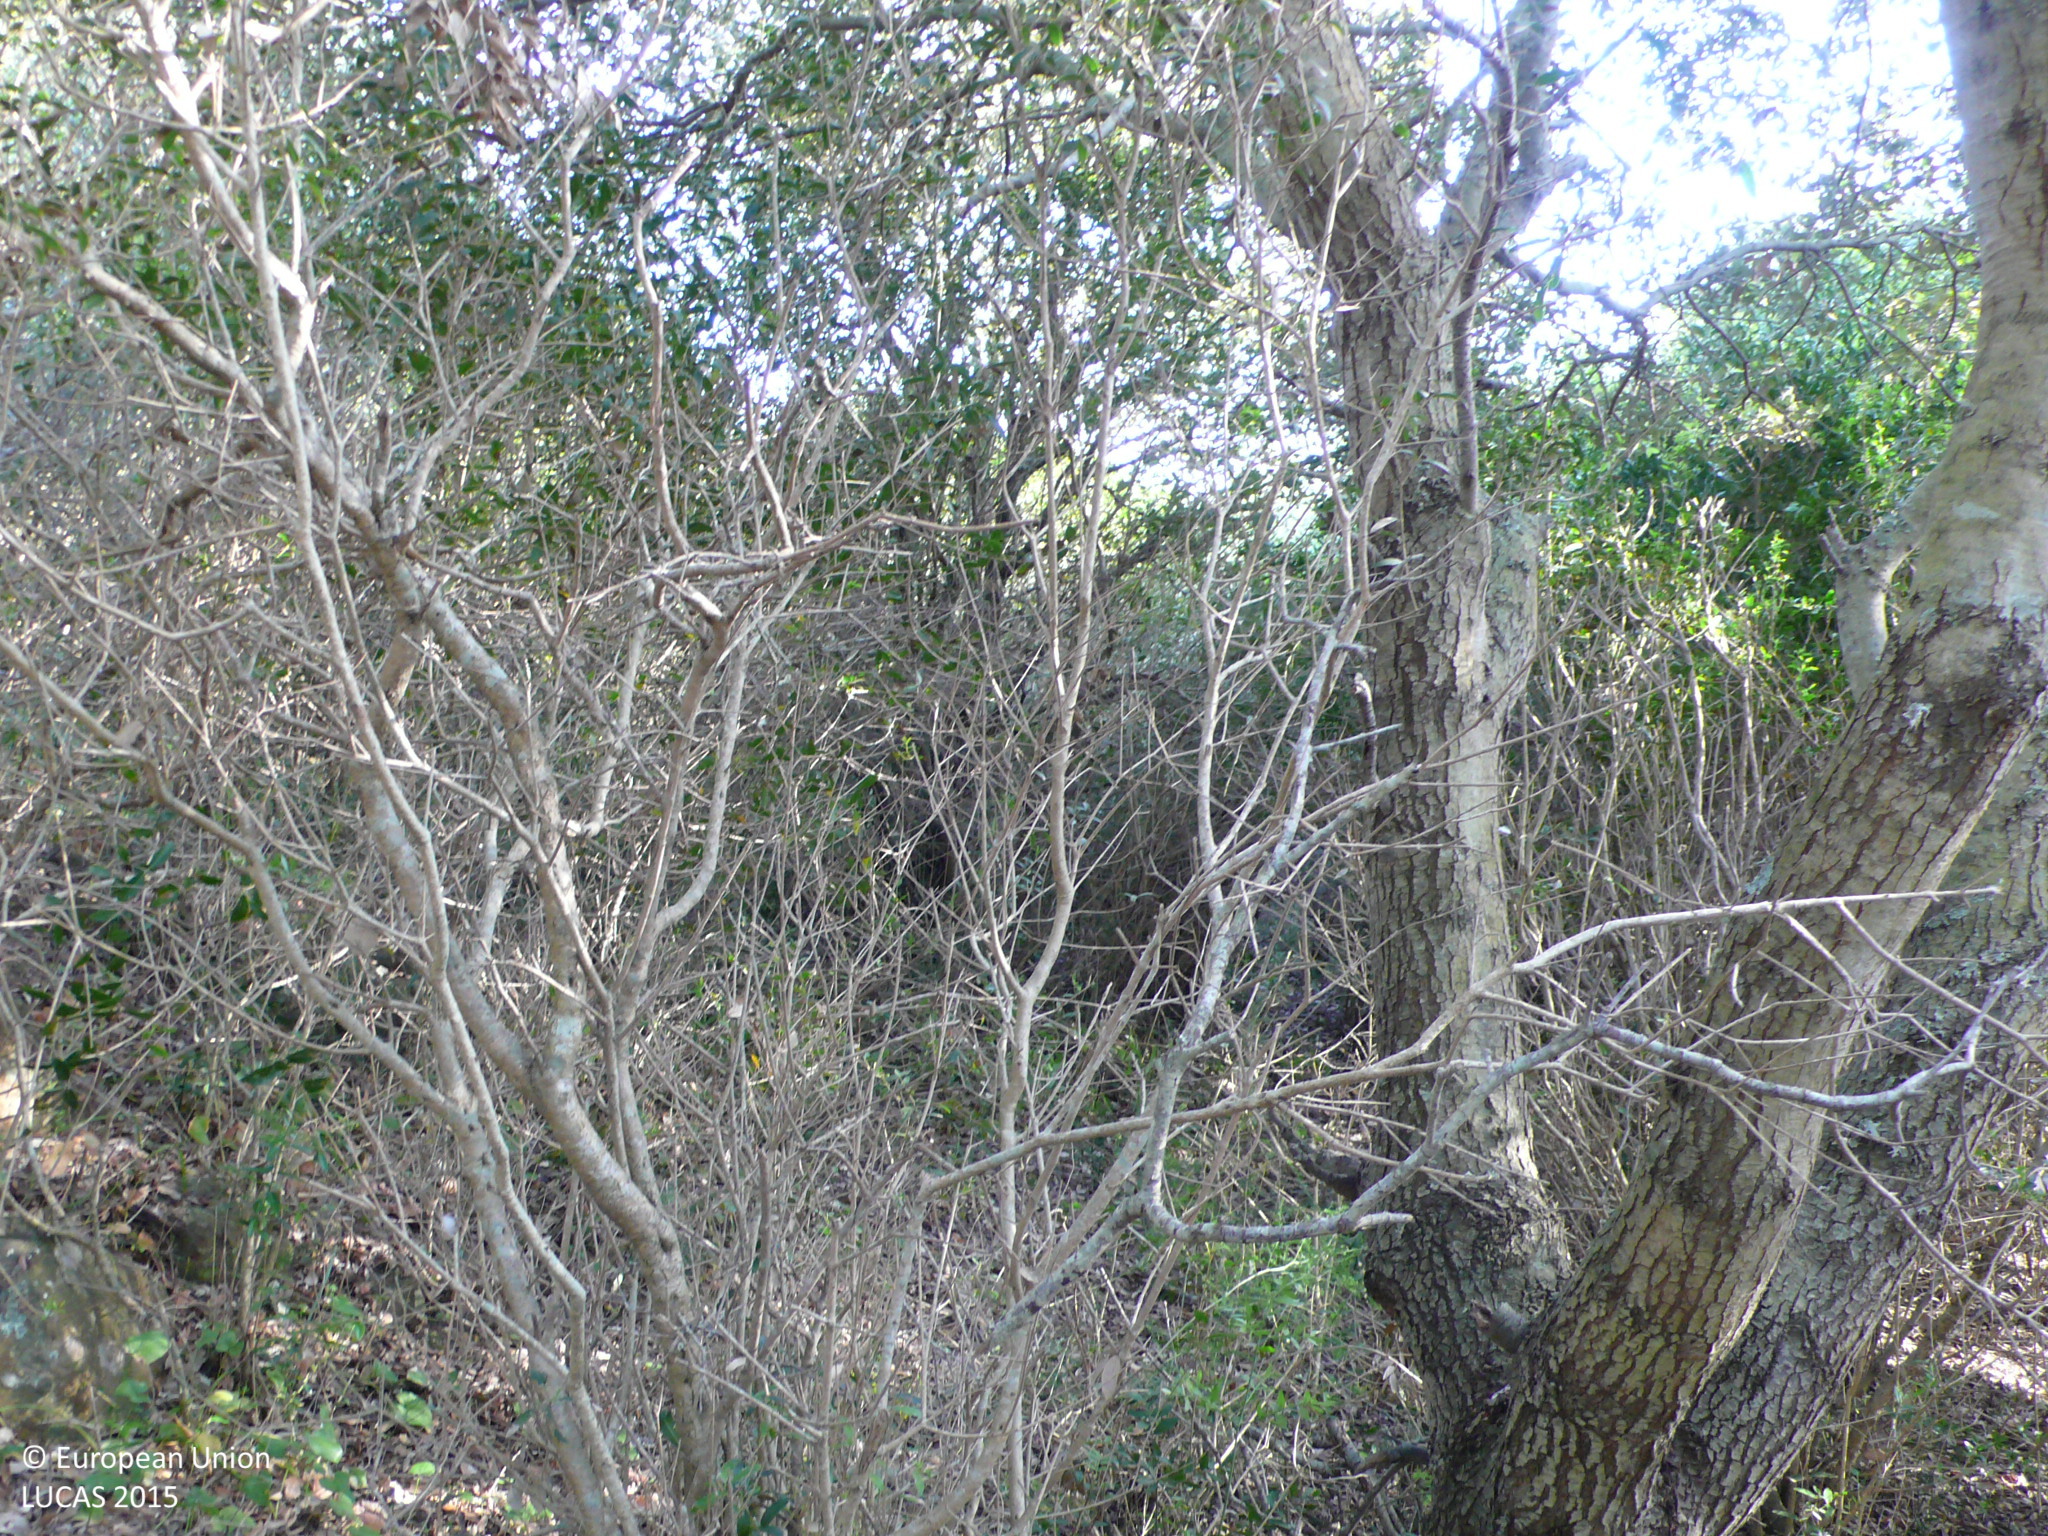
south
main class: Woodland
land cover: Broadleaved woodland
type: thermophilous deciduous forest
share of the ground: > 75 %
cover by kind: broadleaved forest trees 90 %, shrubs 10 %
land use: Semi-natural and natural areas not in use
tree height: > 5 m
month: May
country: ES
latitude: 39.9982
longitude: 4.0874
